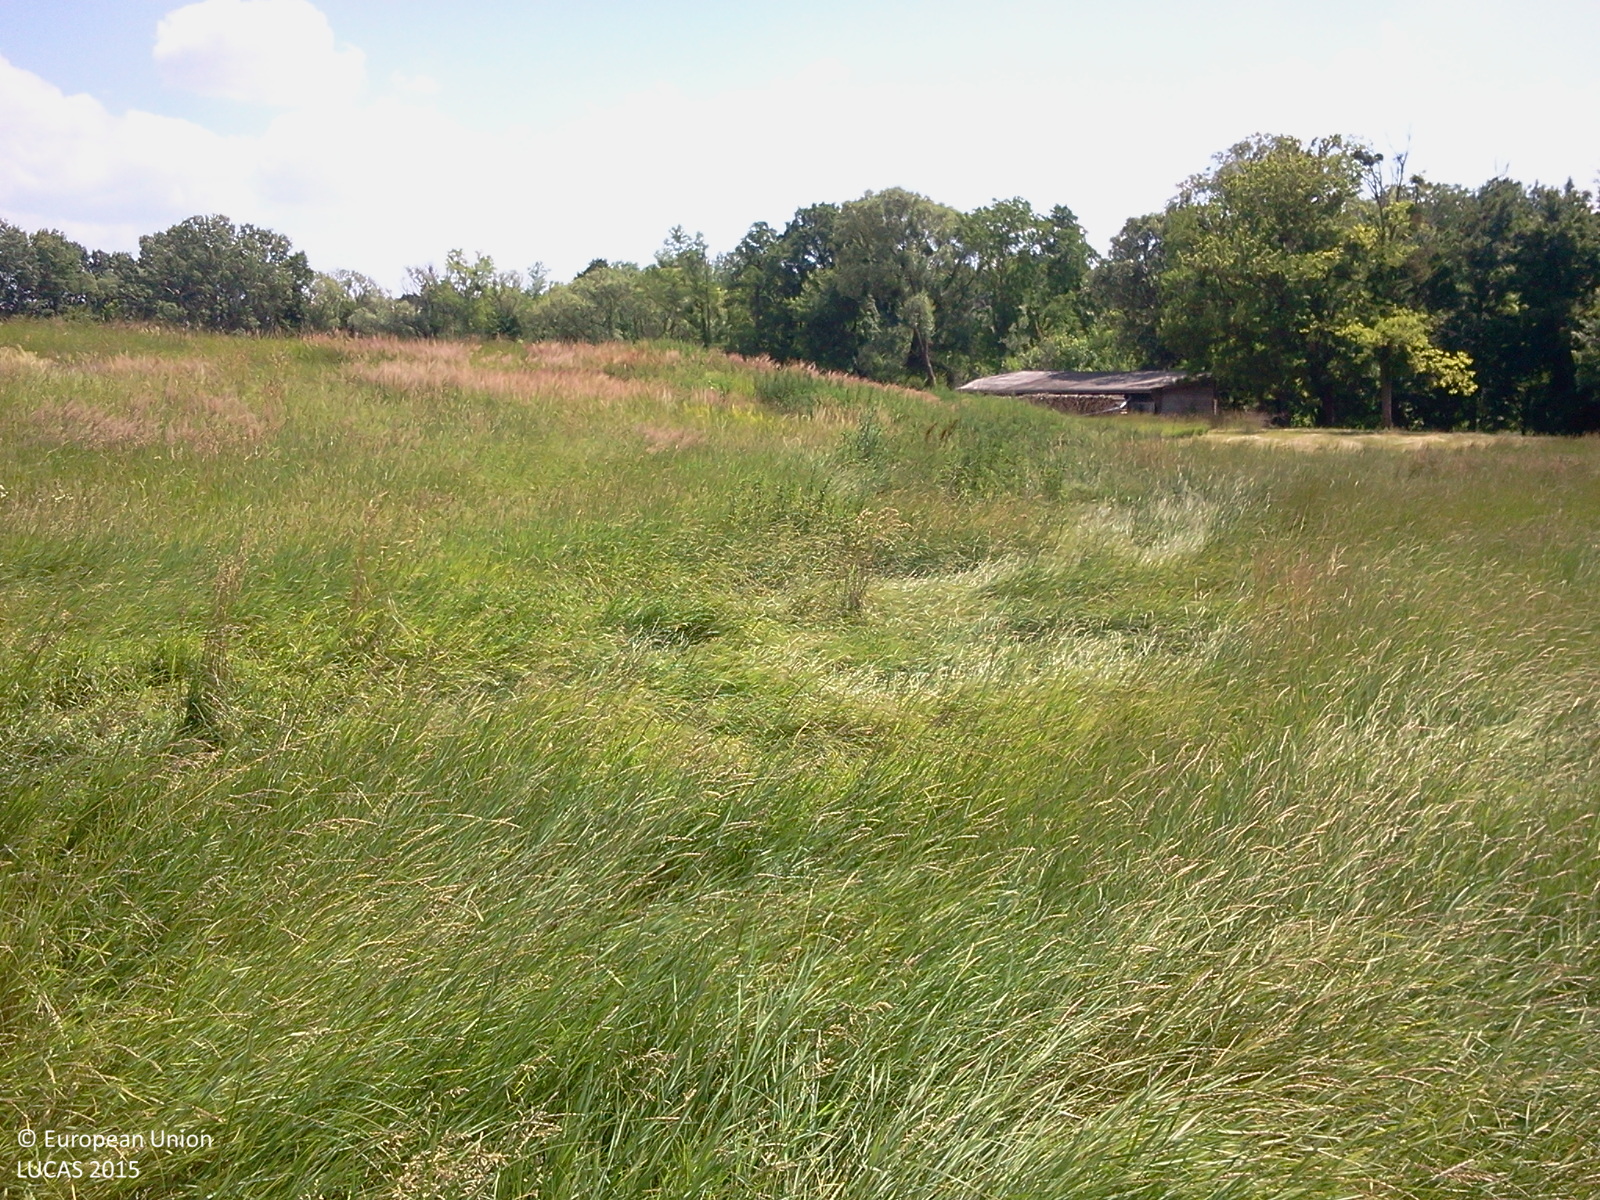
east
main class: Grassland
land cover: Grassland without tree/shrub cover
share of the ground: > 75 %
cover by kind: herbaceous plants 100 %
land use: Agriculture (excluding fallow land and kitchen gardens)
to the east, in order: Grassland without tree/shrub cover; Artificial constructions in urban areas; Broadleaved woodland; Grassland with sparse tree/shrub cover; Rivers and streams; Grassland with sparse tree/shrub cover; Grassland without tree/shrub cover
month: June
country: HU
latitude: 46.8025
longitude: 17.0929
